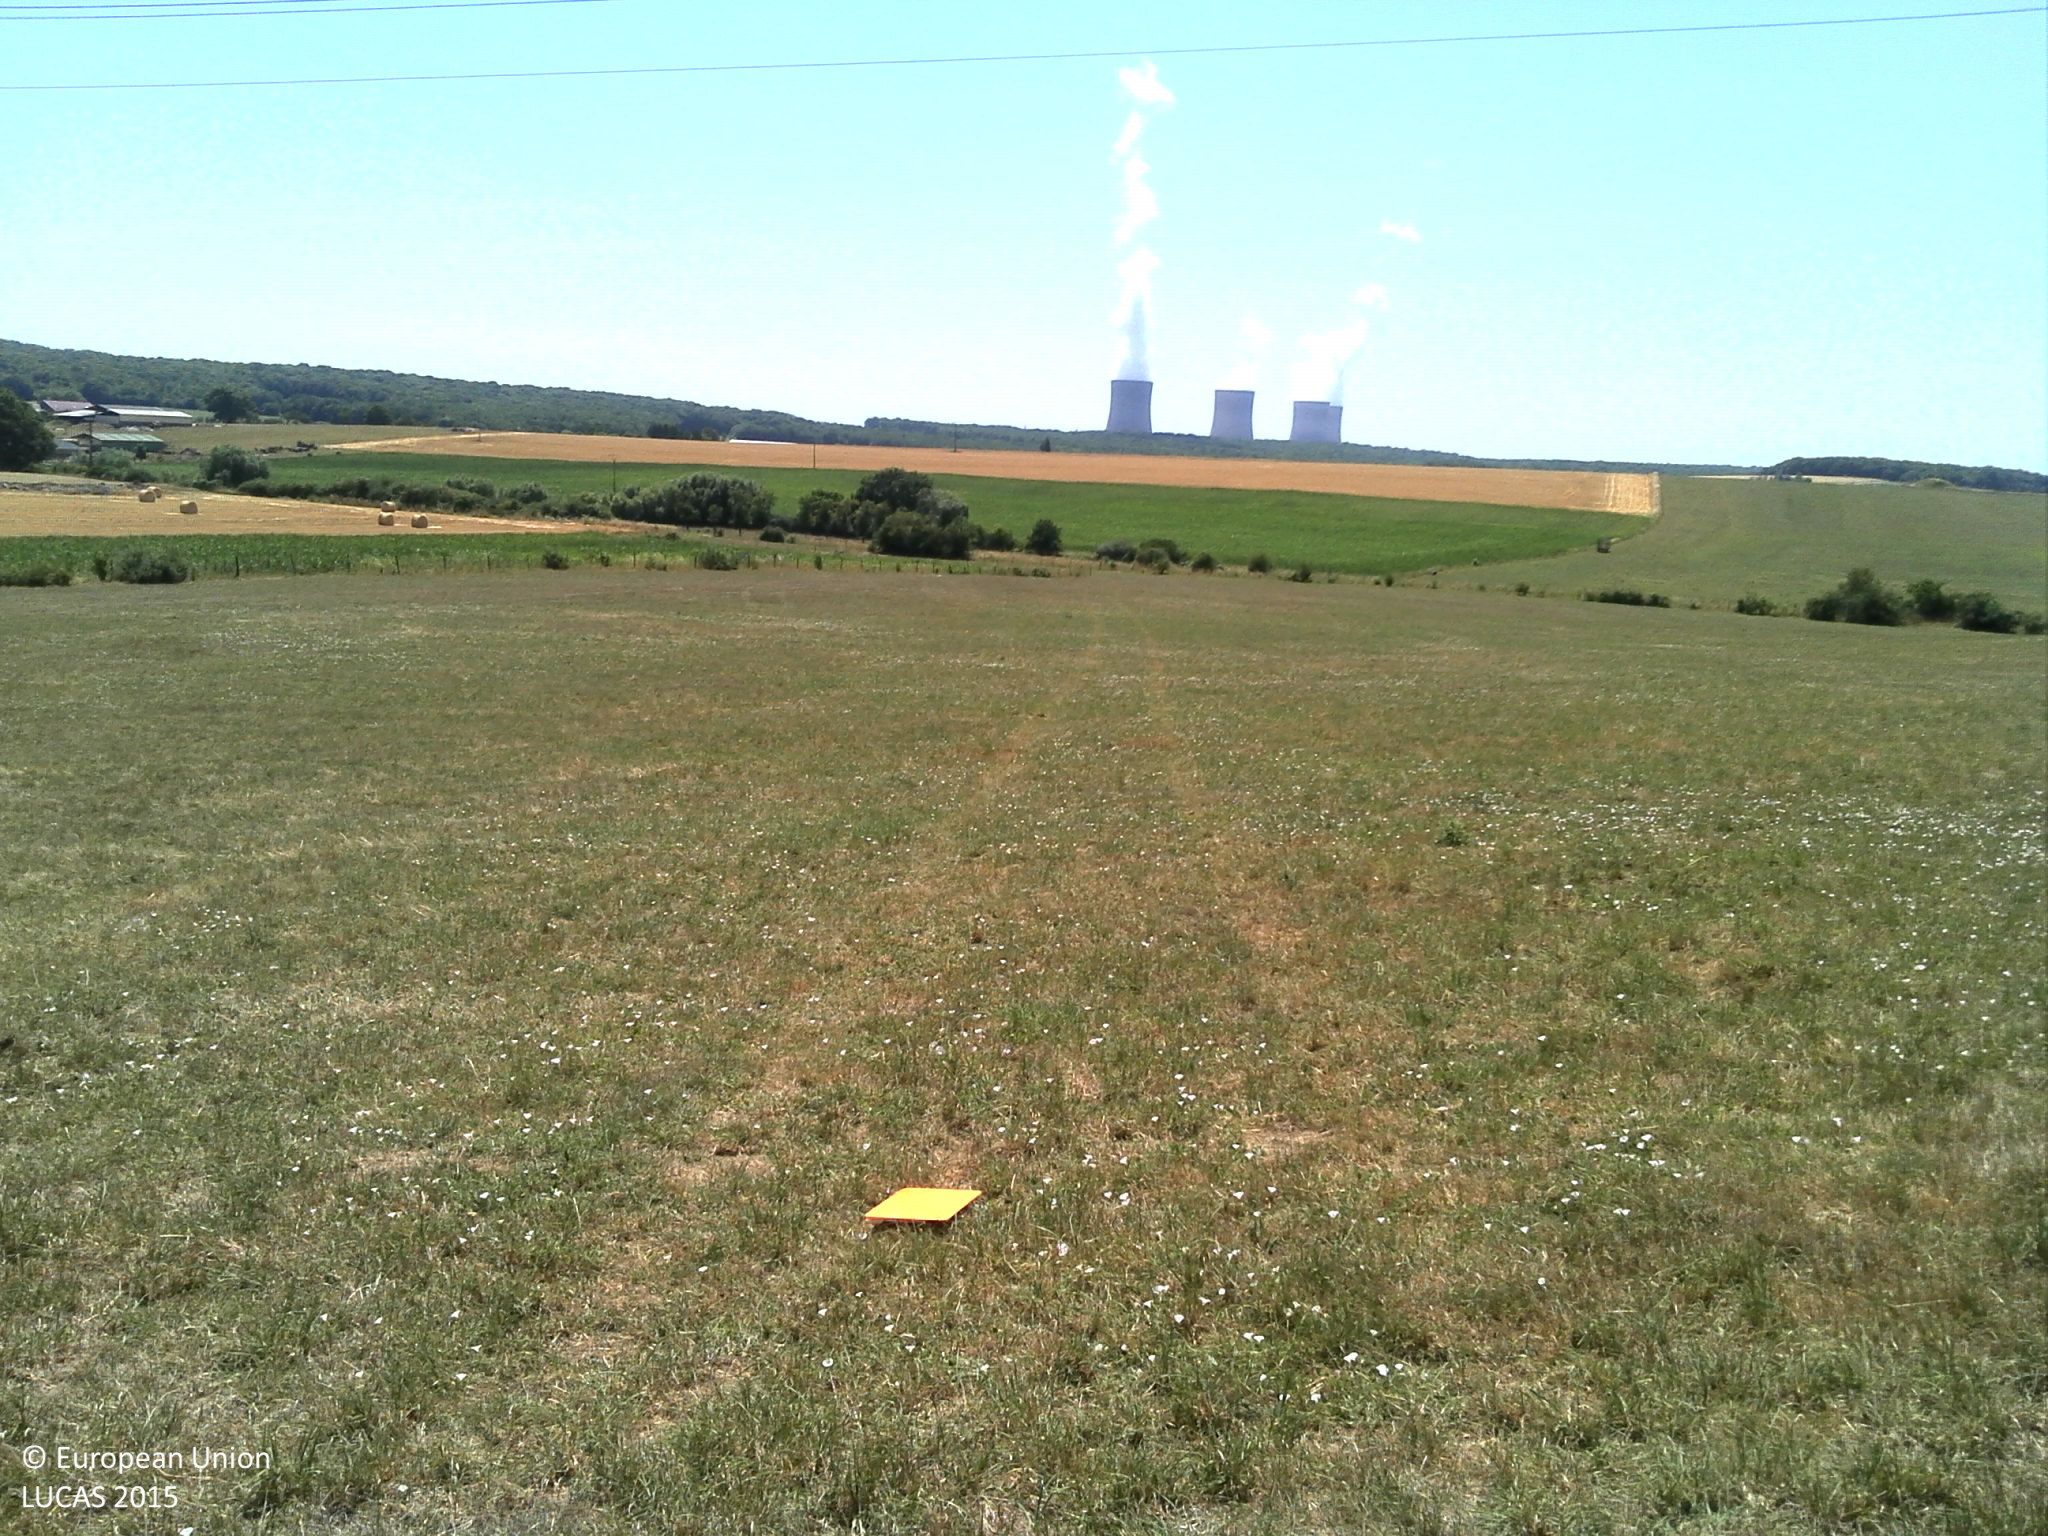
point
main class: Grassland
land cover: Grassland without tree/shrub cover
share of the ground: > 75 %
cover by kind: herbaceous plants 100 %
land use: Agriculture (excluding fallow land and kitchen gardens)
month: July
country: FR
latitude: 49.4559
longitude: 6.2334
